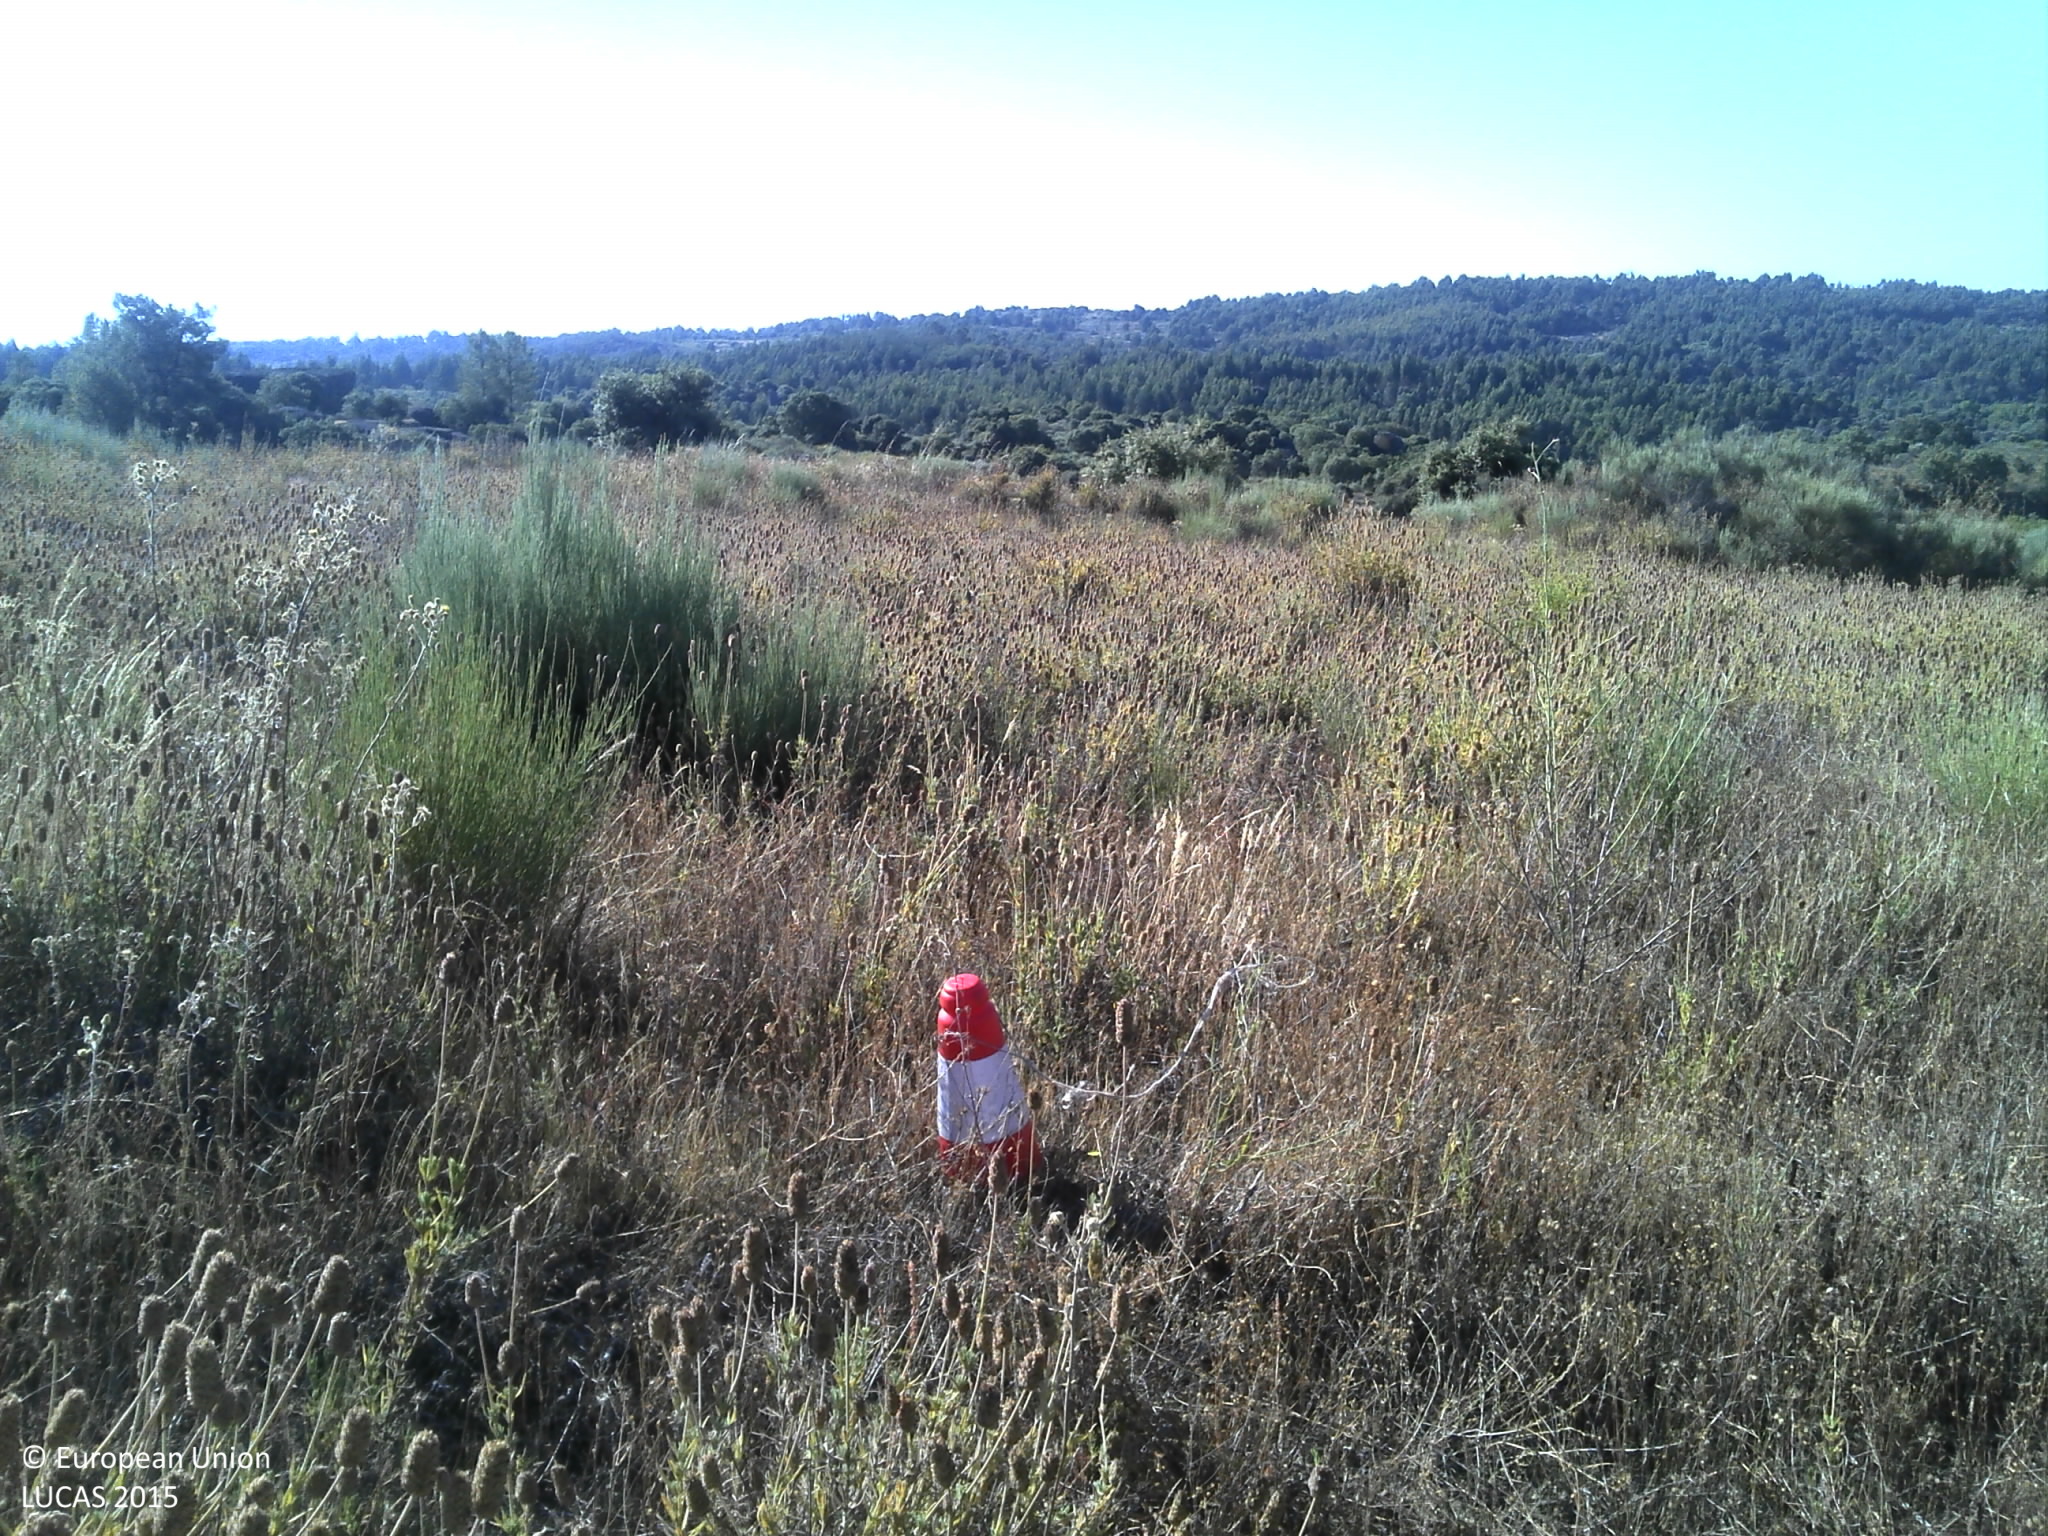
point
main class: Shrubland
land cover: Shrubland with sparse tree cover
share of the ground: 50 - 75 %
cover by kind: shrubs 40 %, herbaceous plants 25 %, unconsolidated bare surface 25 %, broadleaved forest trees 5 %
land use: Agriculture (excluding fallow land and kitchen gardens)
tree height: > 5 m
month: June
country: PT
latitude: 40.0604
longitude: -7.3210
